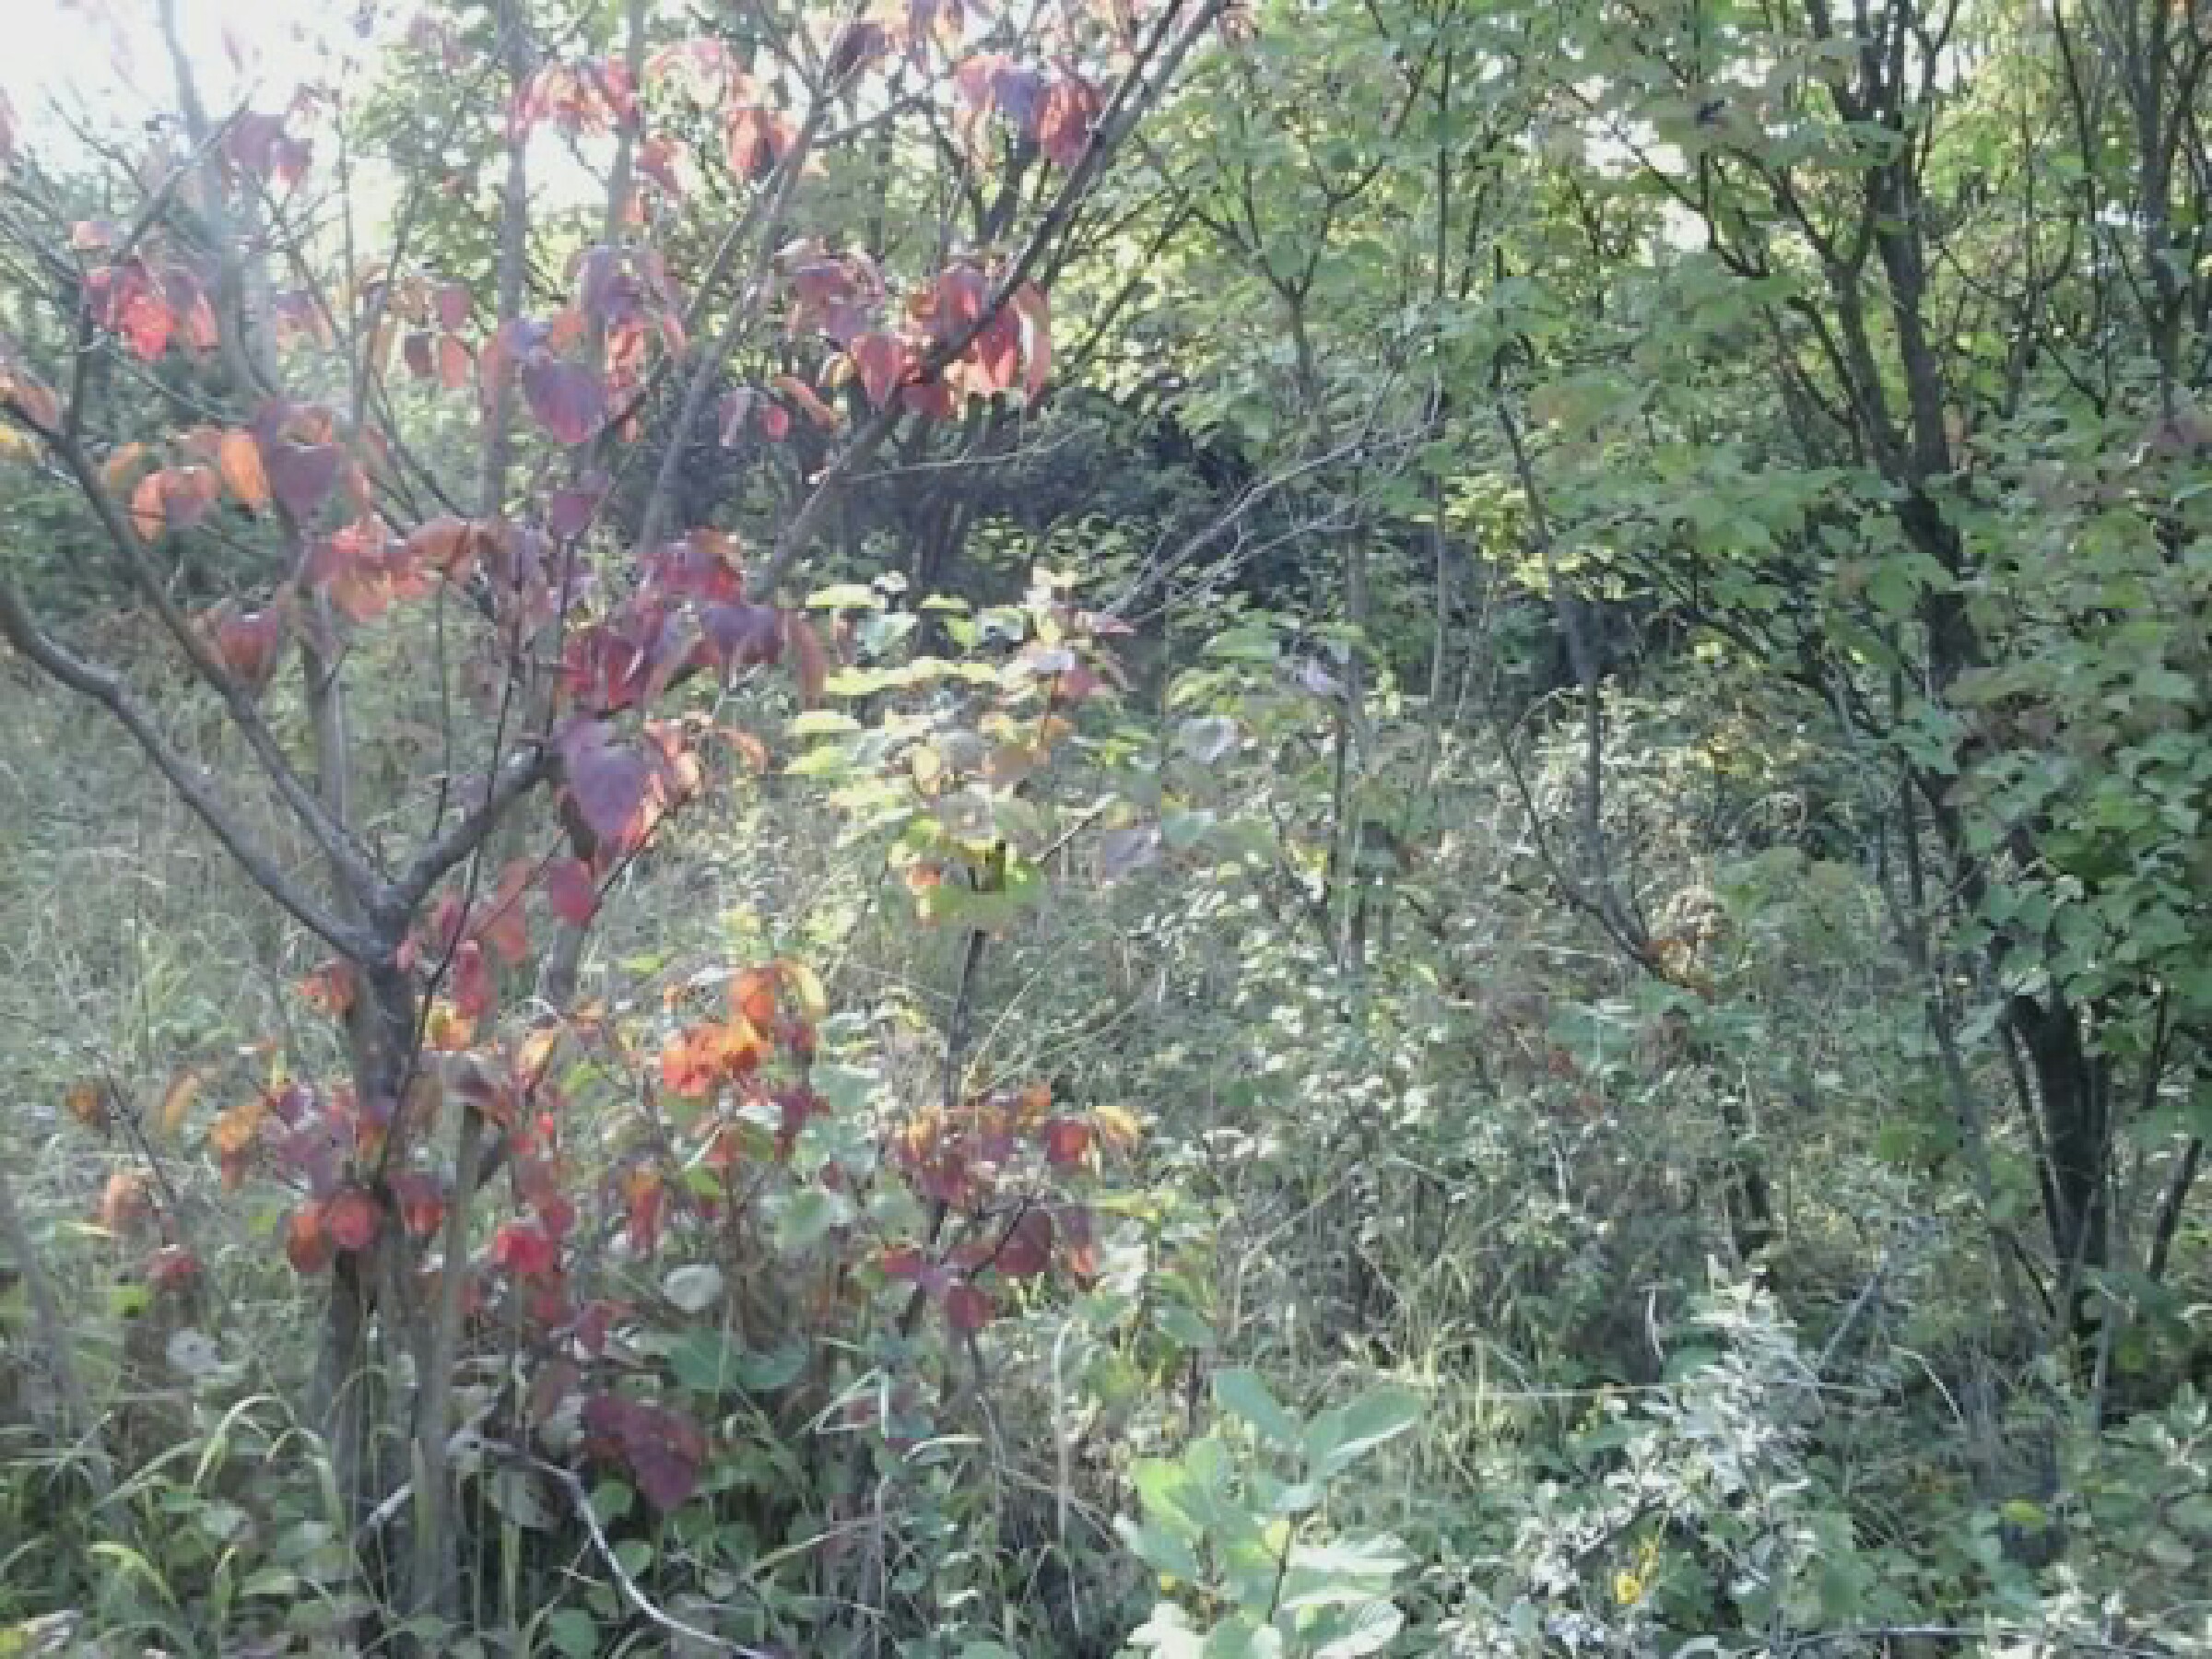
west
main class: Shrubland
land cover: Shrubland with sparse tree cover
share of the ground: > 75 %
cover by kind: shrubs 80 %, herbaceous plants 15 %, broadleaved forest trees 5 %
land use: Semi-natural and natural areas not in use
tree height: > 5 m
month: August
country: HU
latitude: 48.0519
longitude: 19.4546
